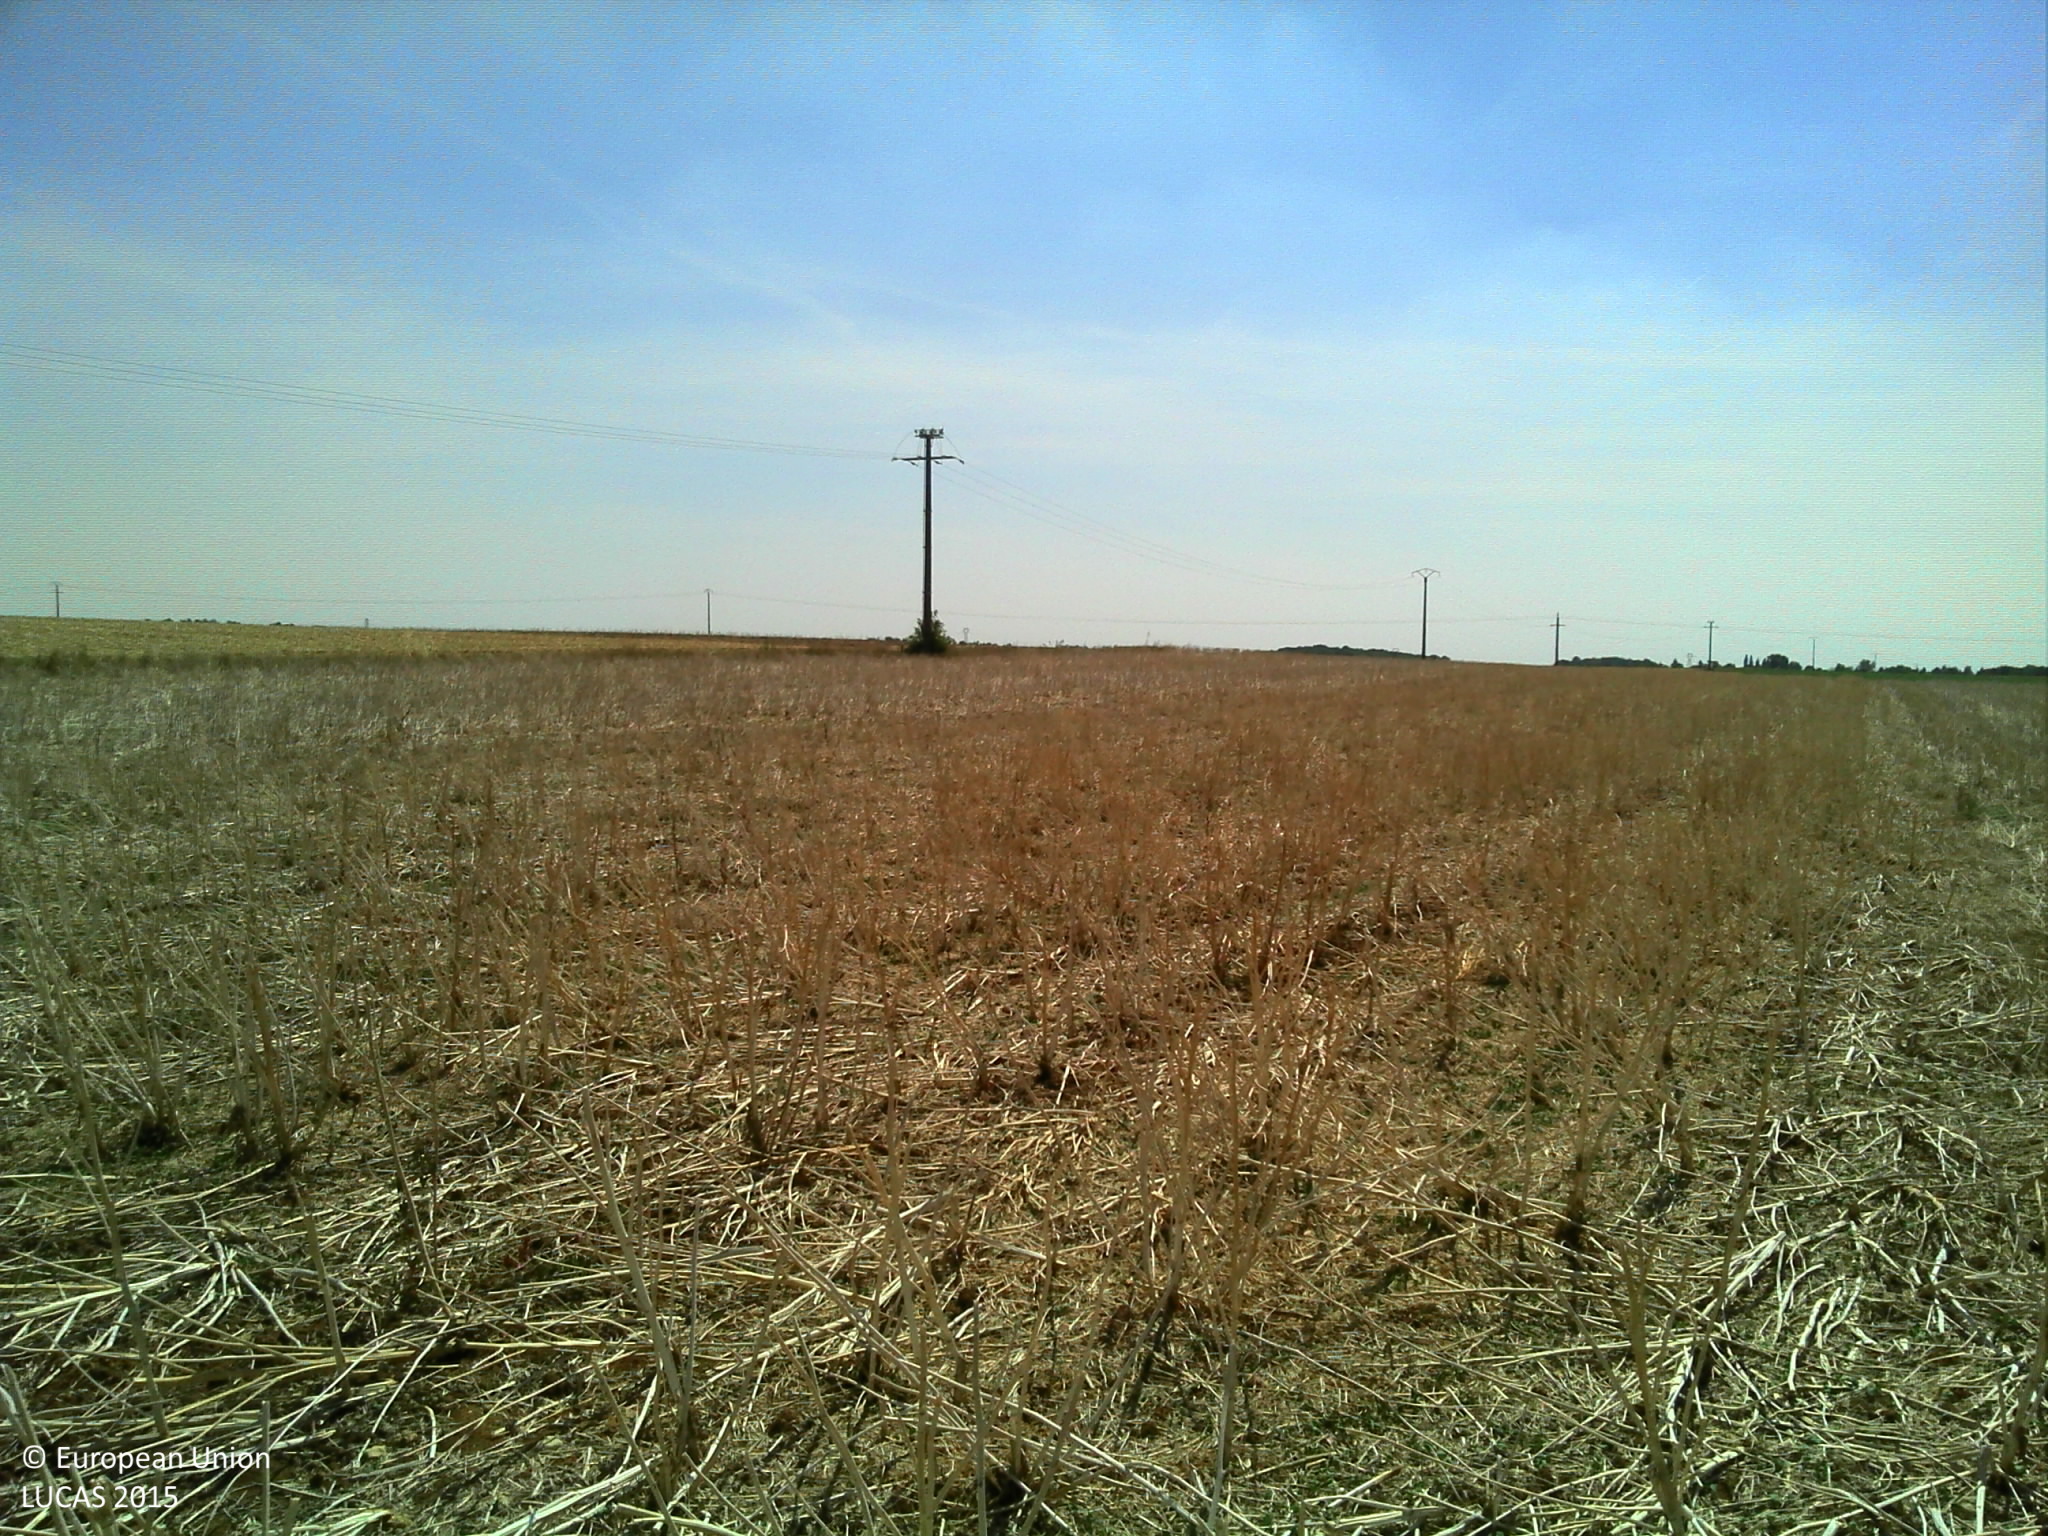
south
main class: Cropland
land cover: Rape and turnip rape
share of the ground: > 75 %
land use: Agriculture (excluding fallow land and kitchen gardens)
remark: Harvested field
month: August
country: FR
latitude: 48.2222
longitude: 2.7901
